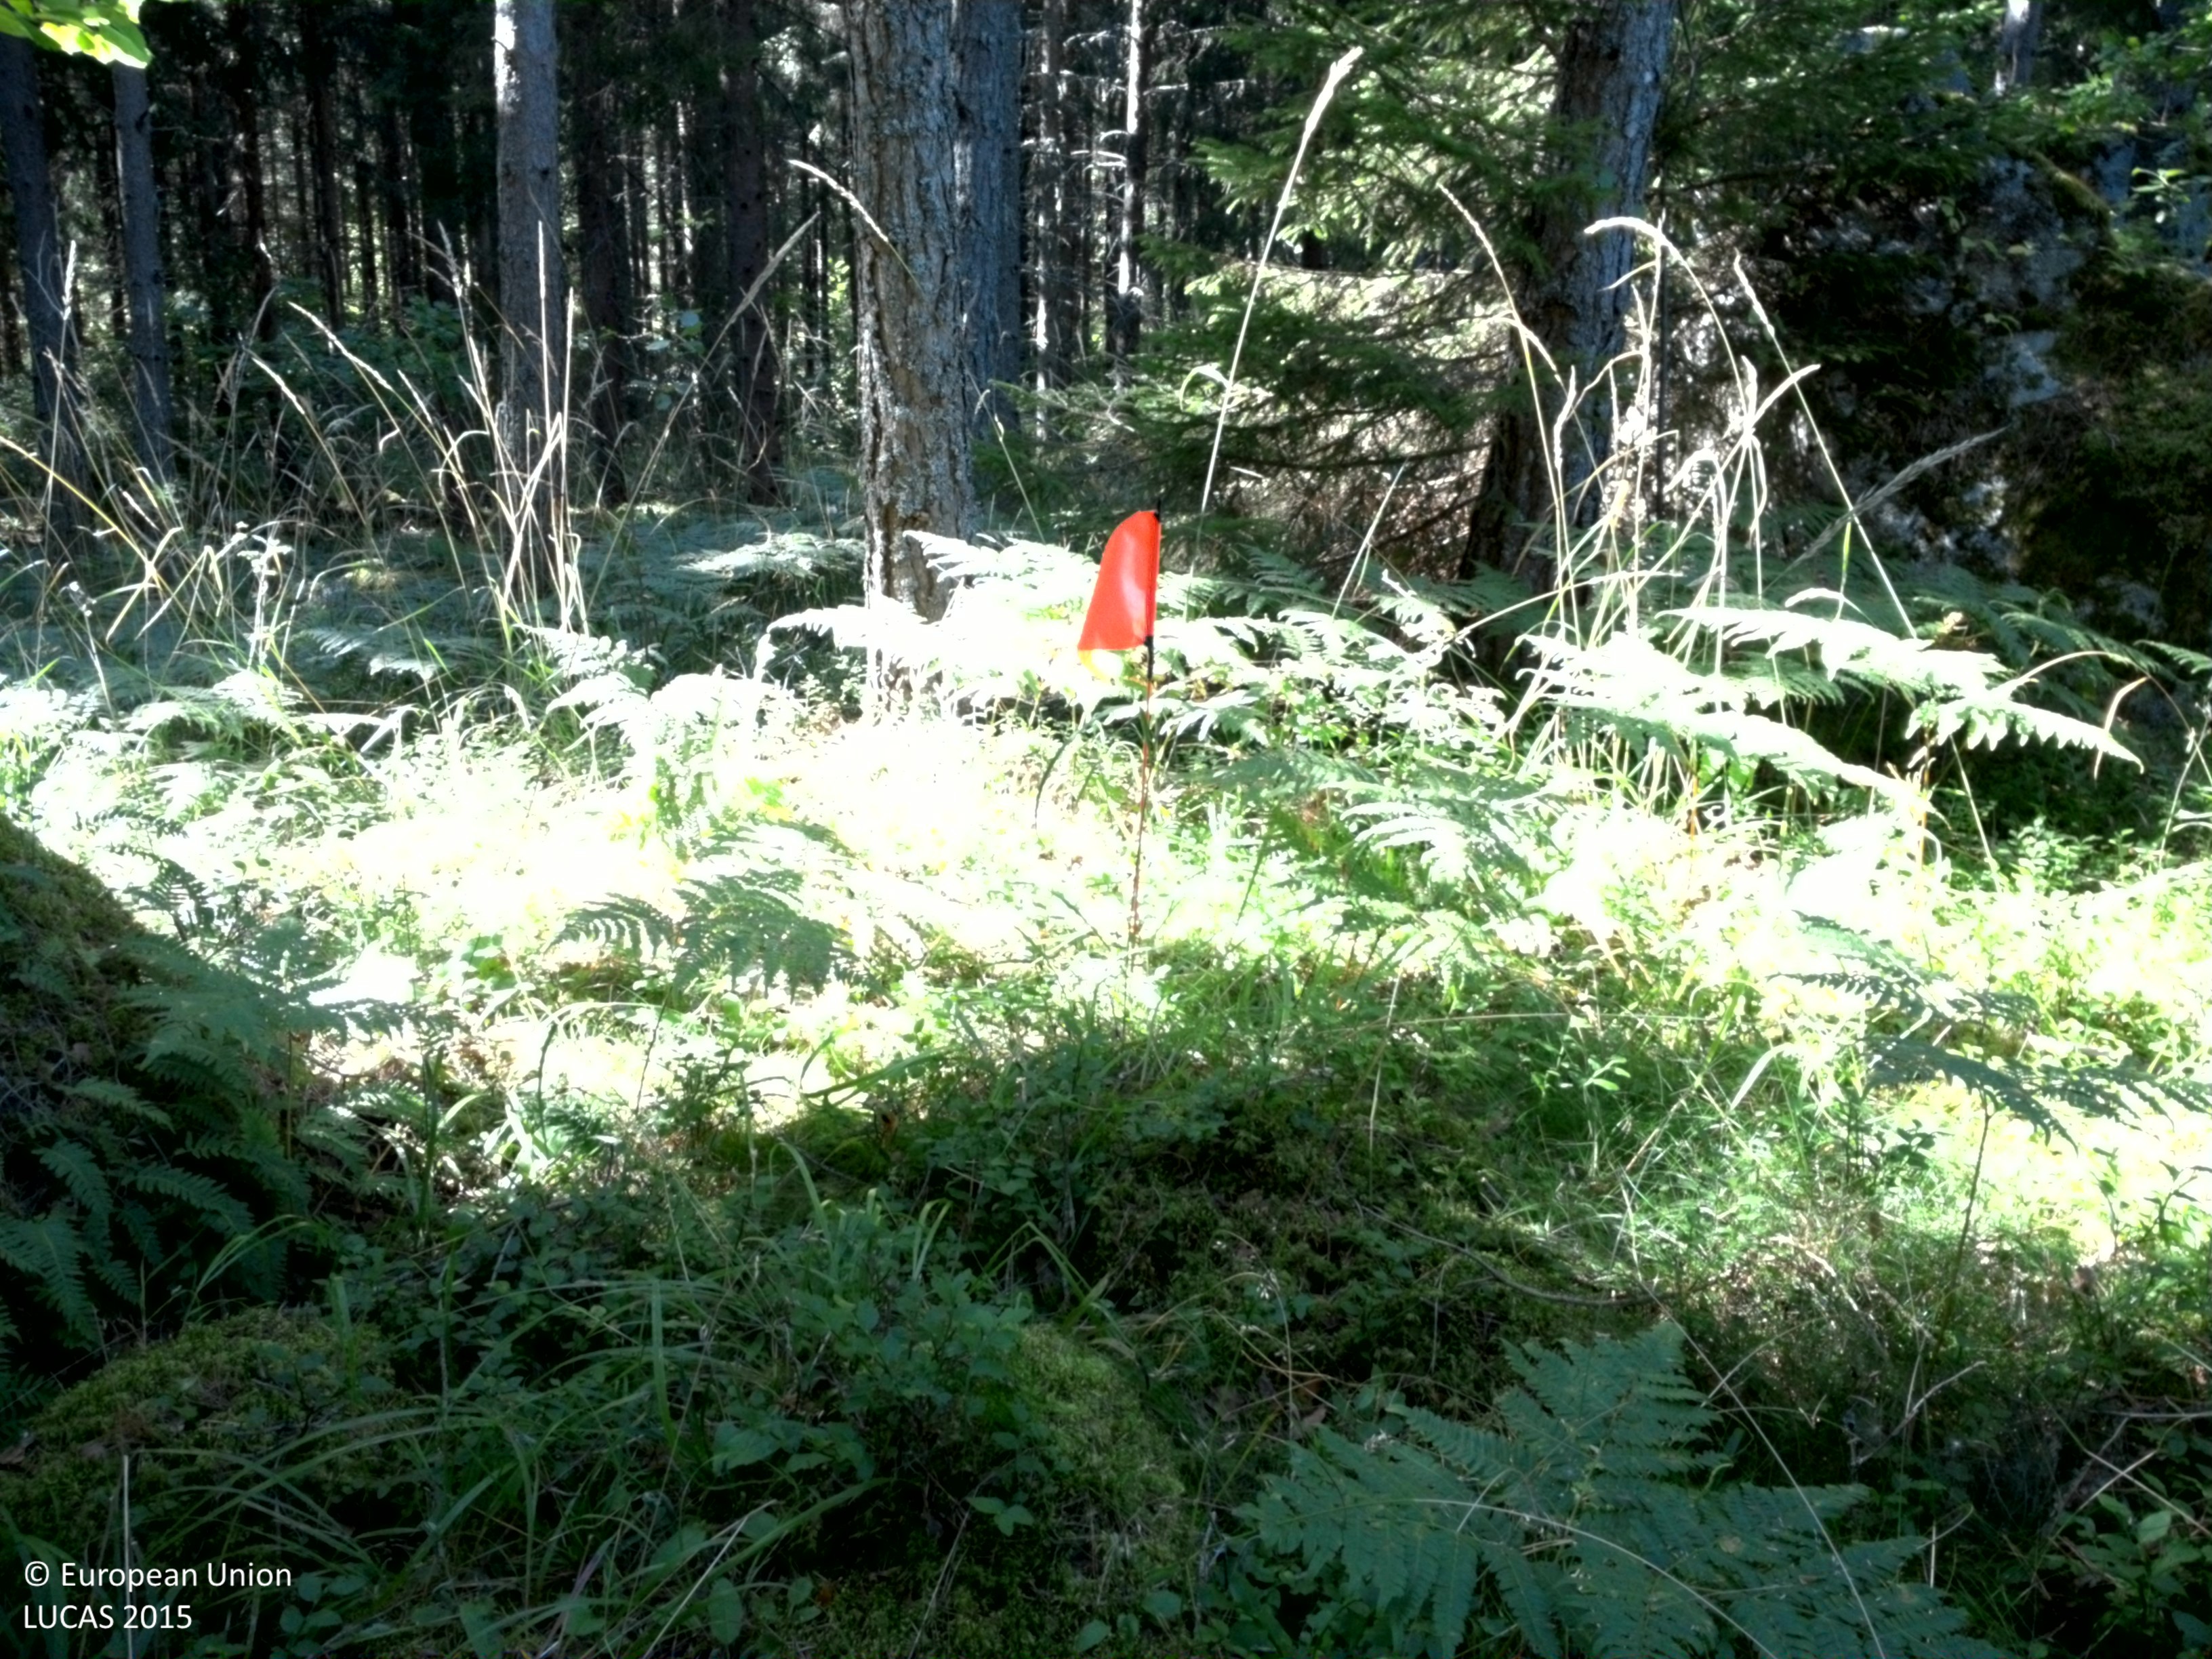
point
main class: Woodland
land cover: Pine dominated coniferous woodland
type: boreal forest
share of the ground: > 75 %
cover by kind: coniferous forest trees 70 %, shrubs 15 %, broadleaved forest trees 5 %, herbaceous plants 5 %, lichens and mosses 5 %
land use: Forestry
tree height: > 5 m
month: August
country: SE
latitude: 59.9713
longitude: 18.0032
